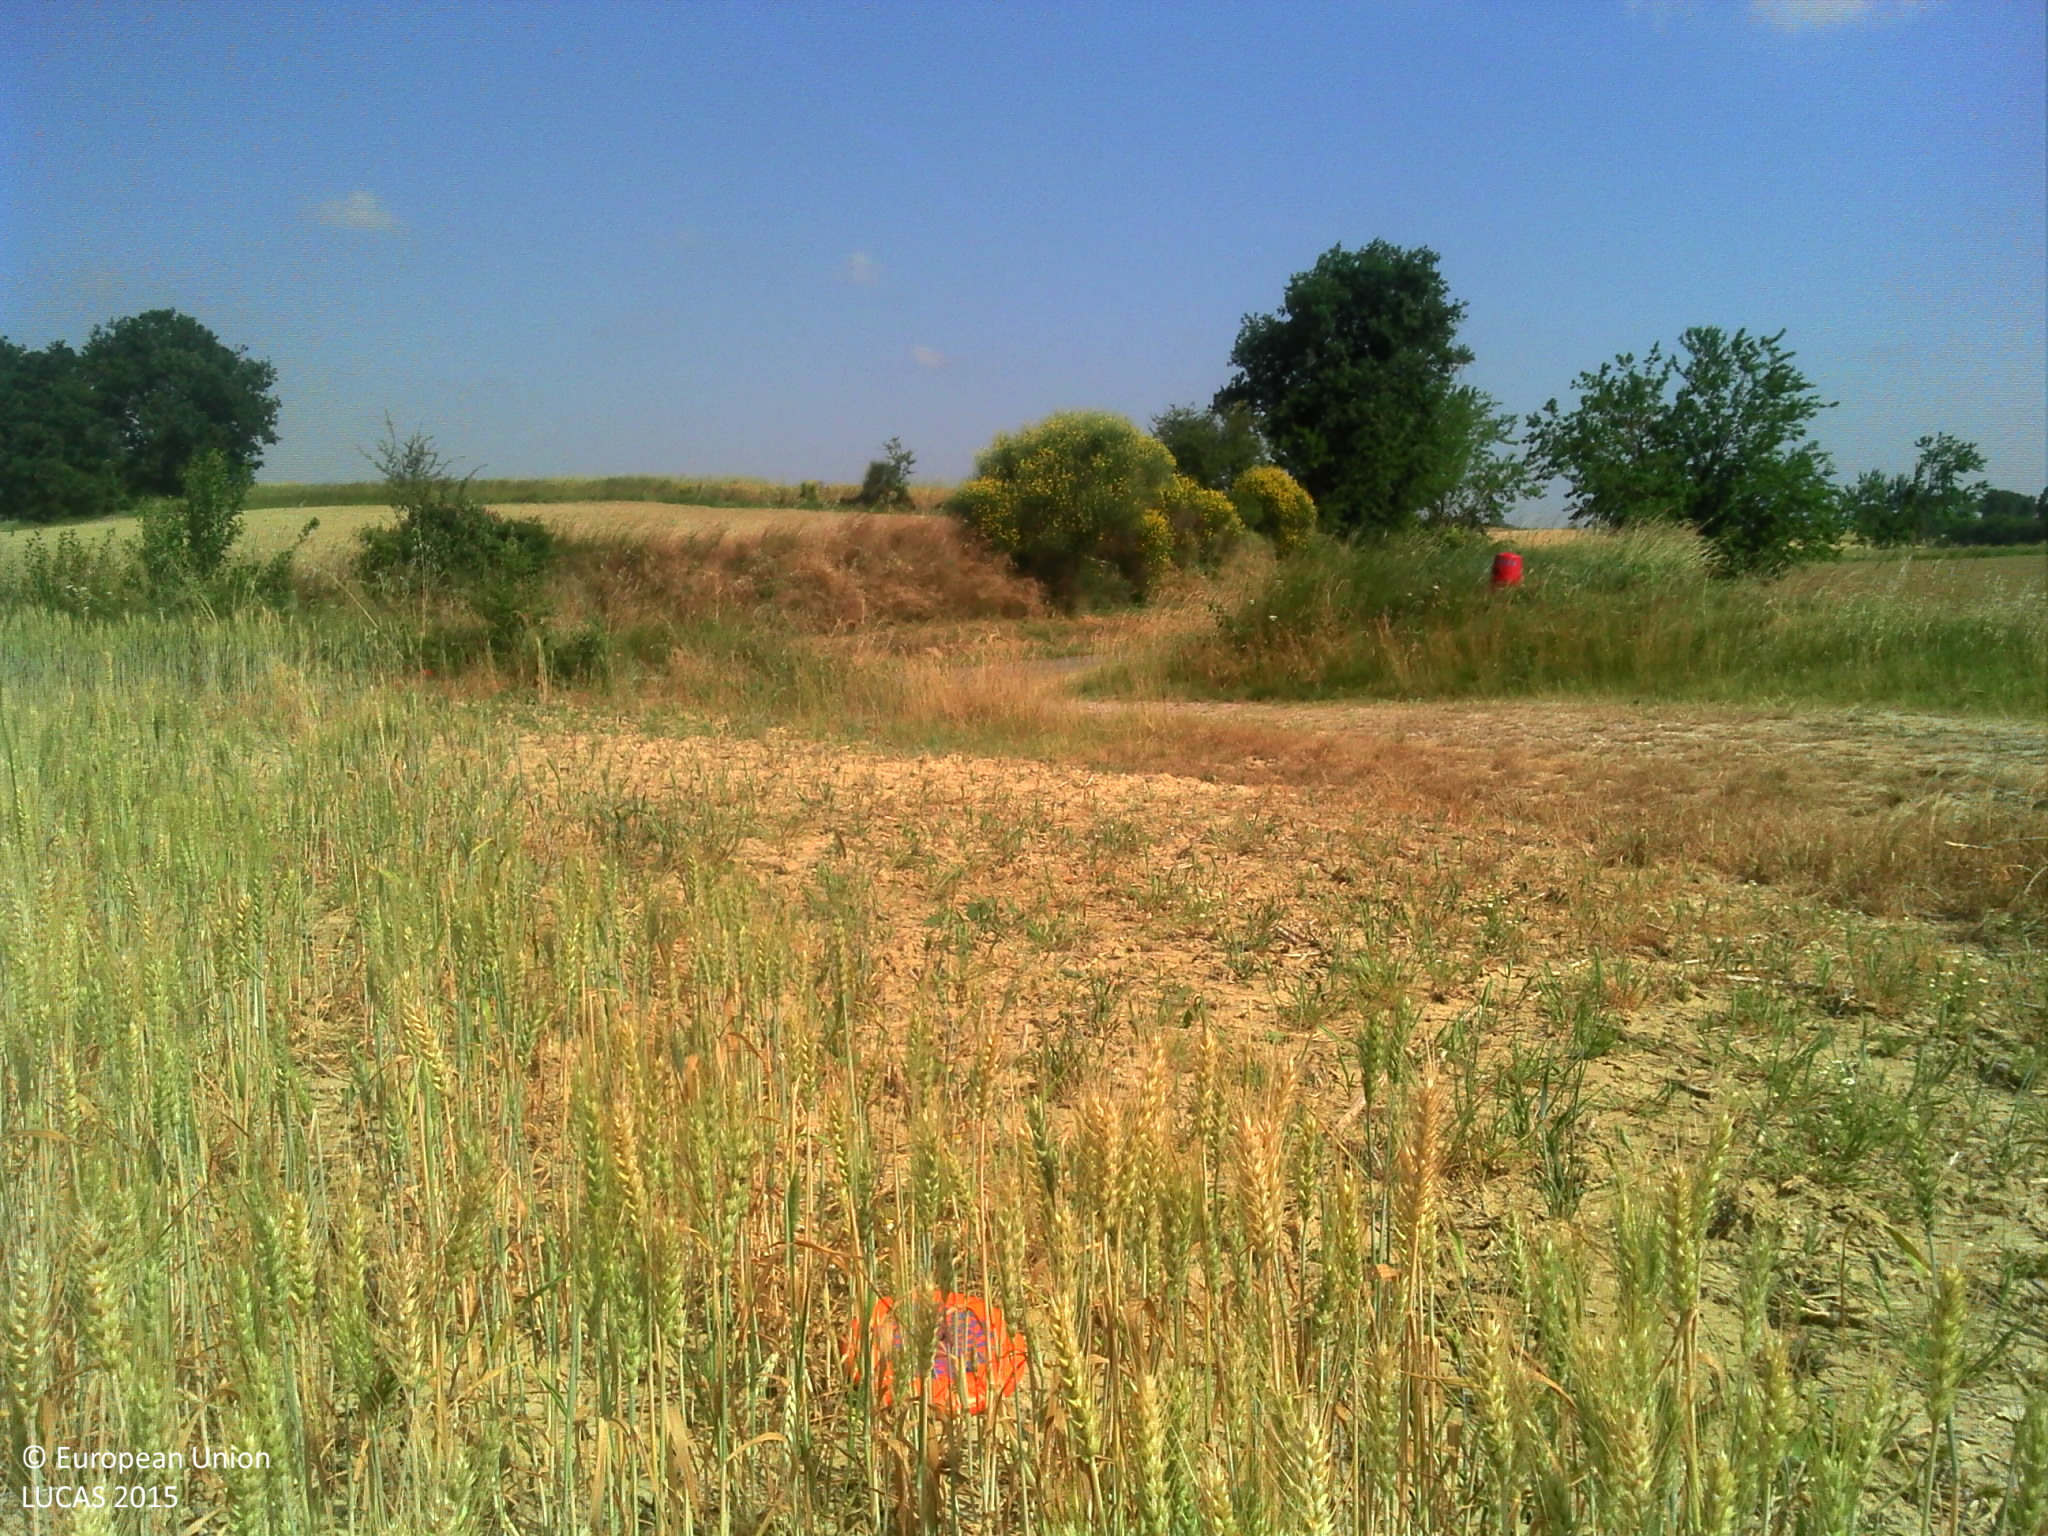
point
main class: Cropland
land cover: Common wheat
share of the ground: 50 - 75 %
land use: Agriculture (excluding fallow land and kitchen gardens)
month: June
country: FR
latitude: 43.8728
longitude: 1.7020
